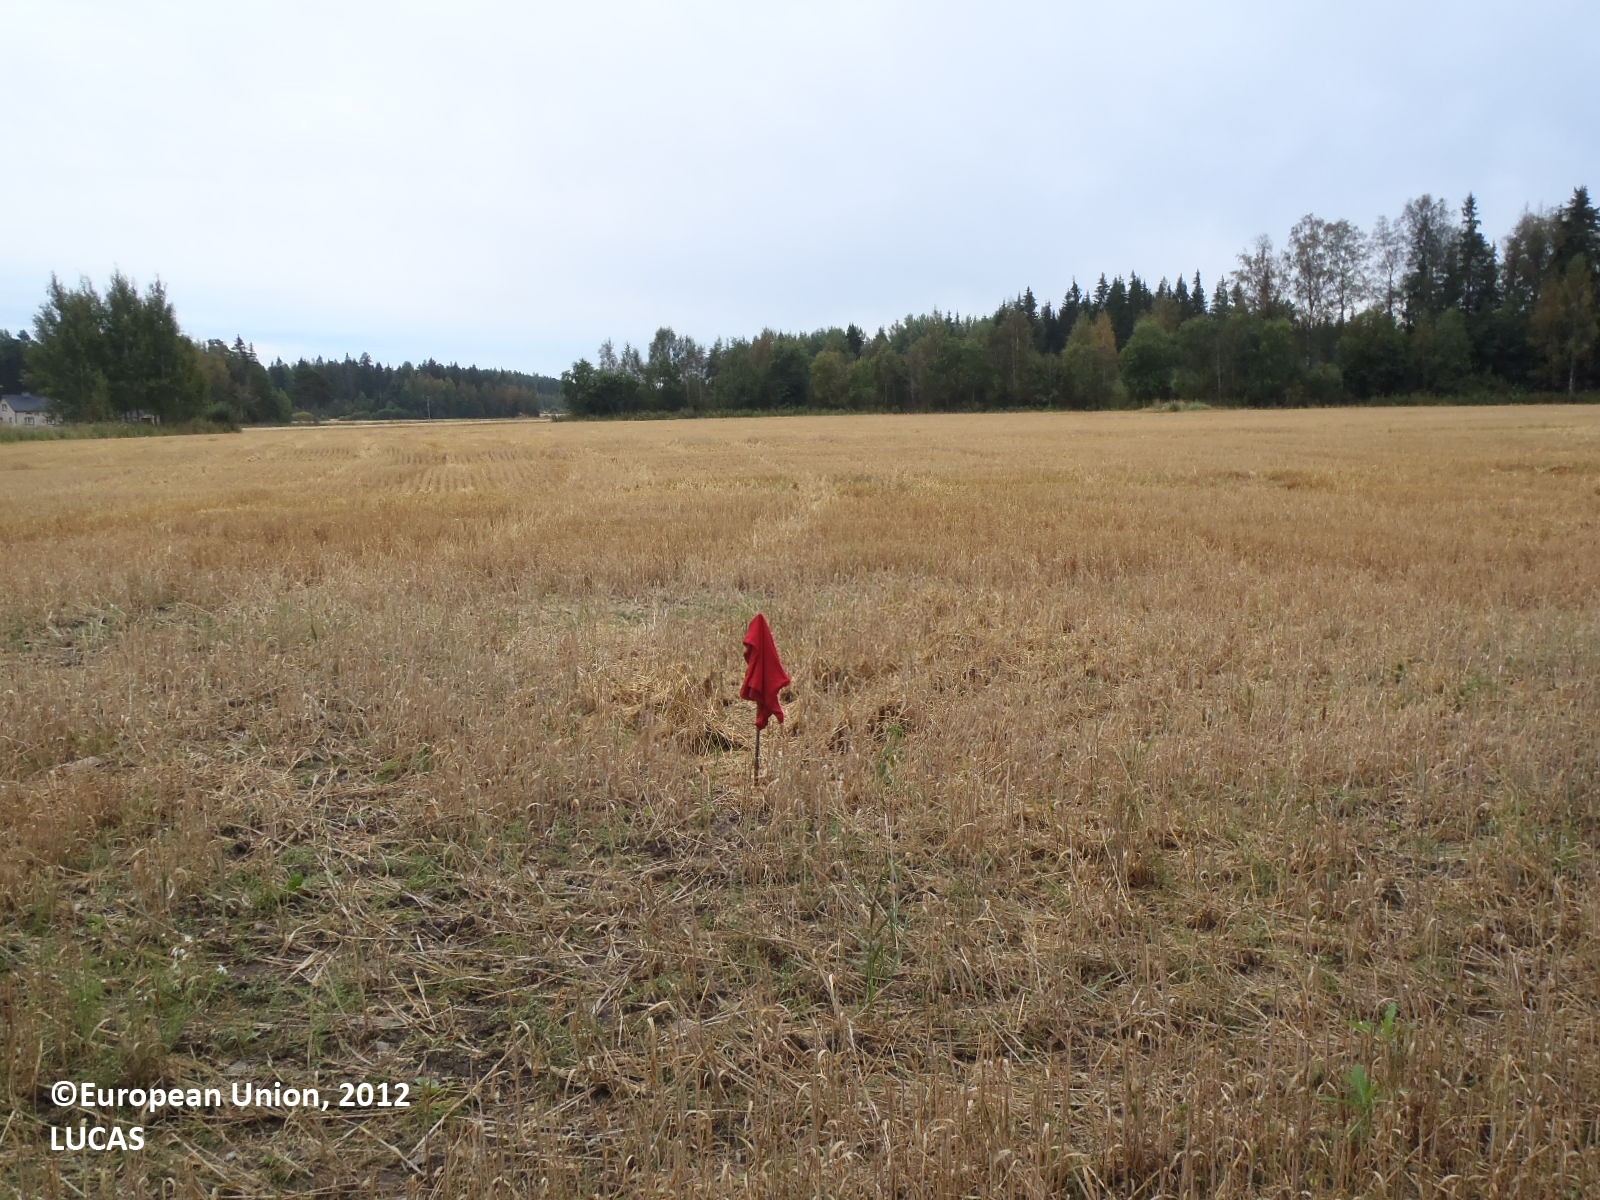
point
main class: Cropland
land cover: Barley
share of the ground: > 75 %
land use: Agriculture (excluding fallow land and kitchen gardens)
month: August
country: FI
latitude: 60.8754
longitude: 21.9401
